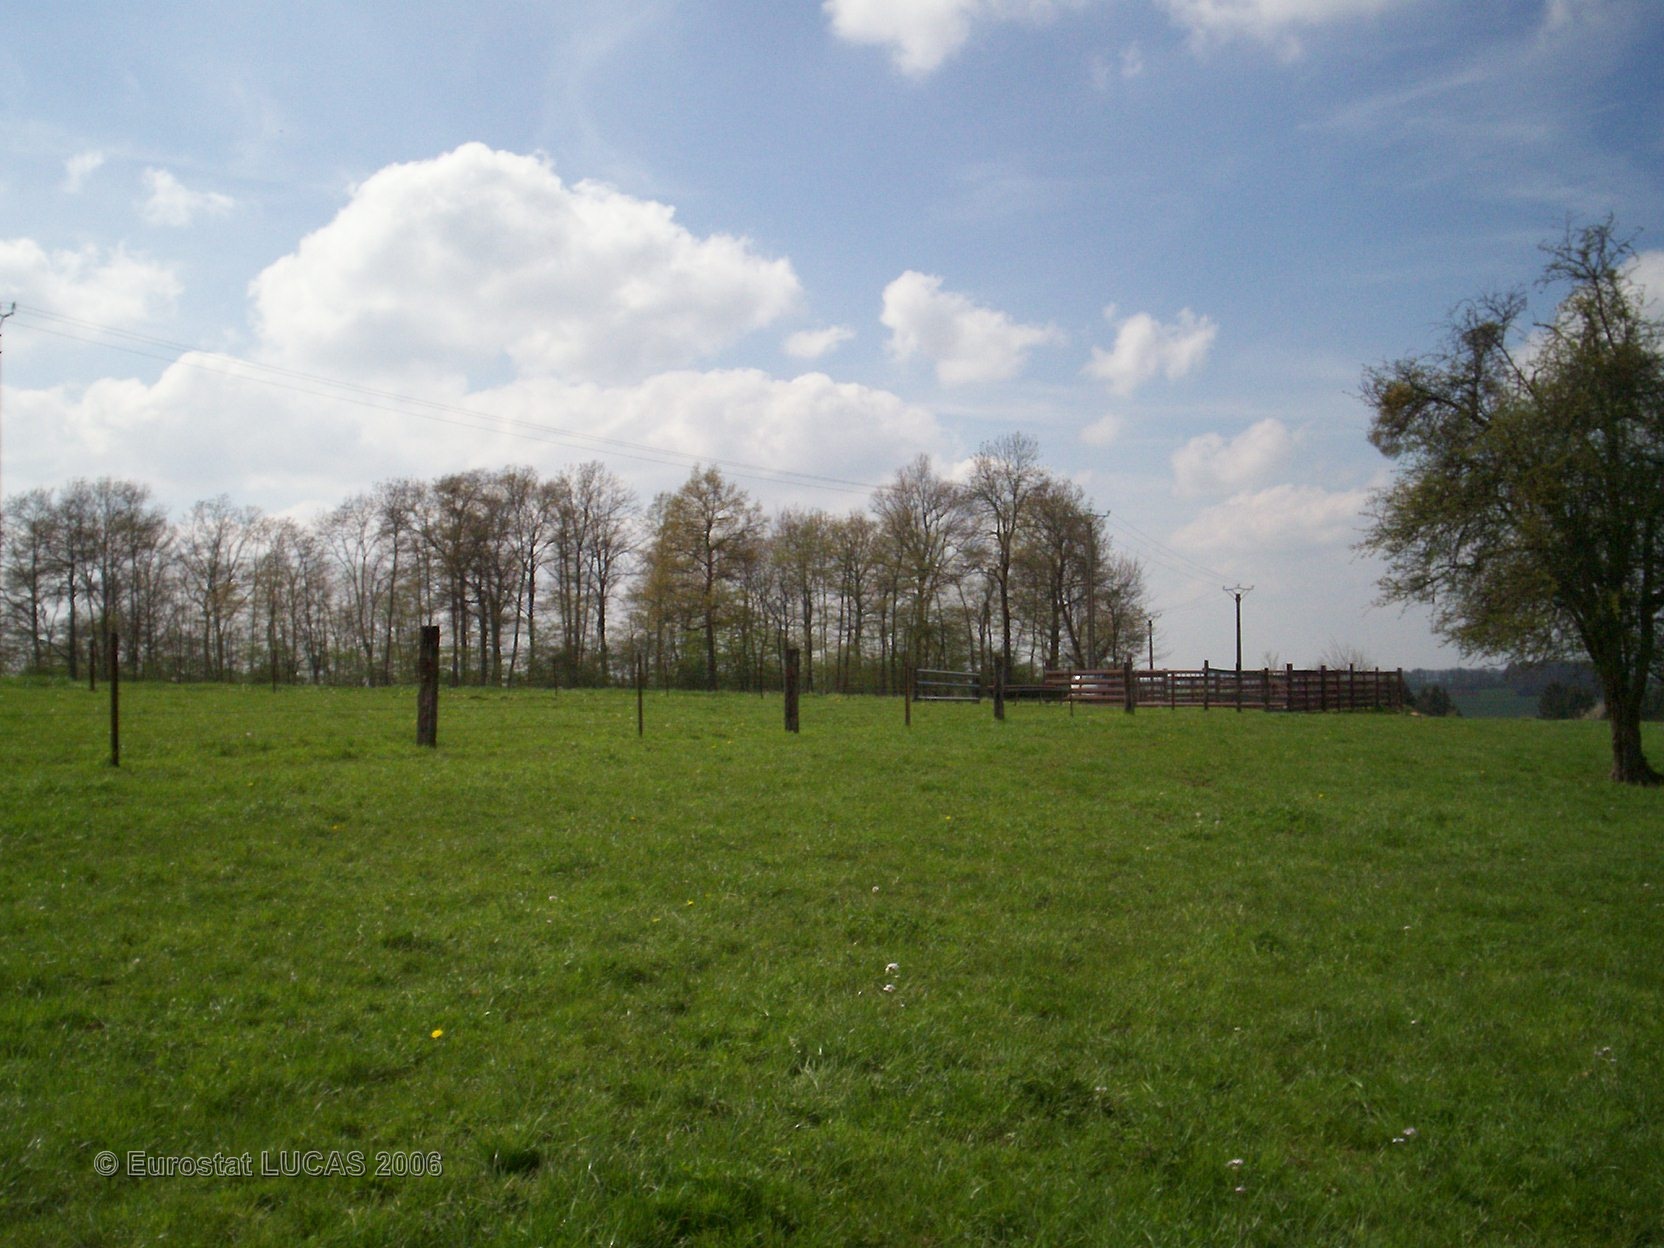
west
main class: Grassland
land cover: Grassland without tree/shrub cover
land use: Agriculture (excluding fallow land and kitchen gardens)
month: May
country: FR
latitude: 49.8286
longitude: 4.3655
